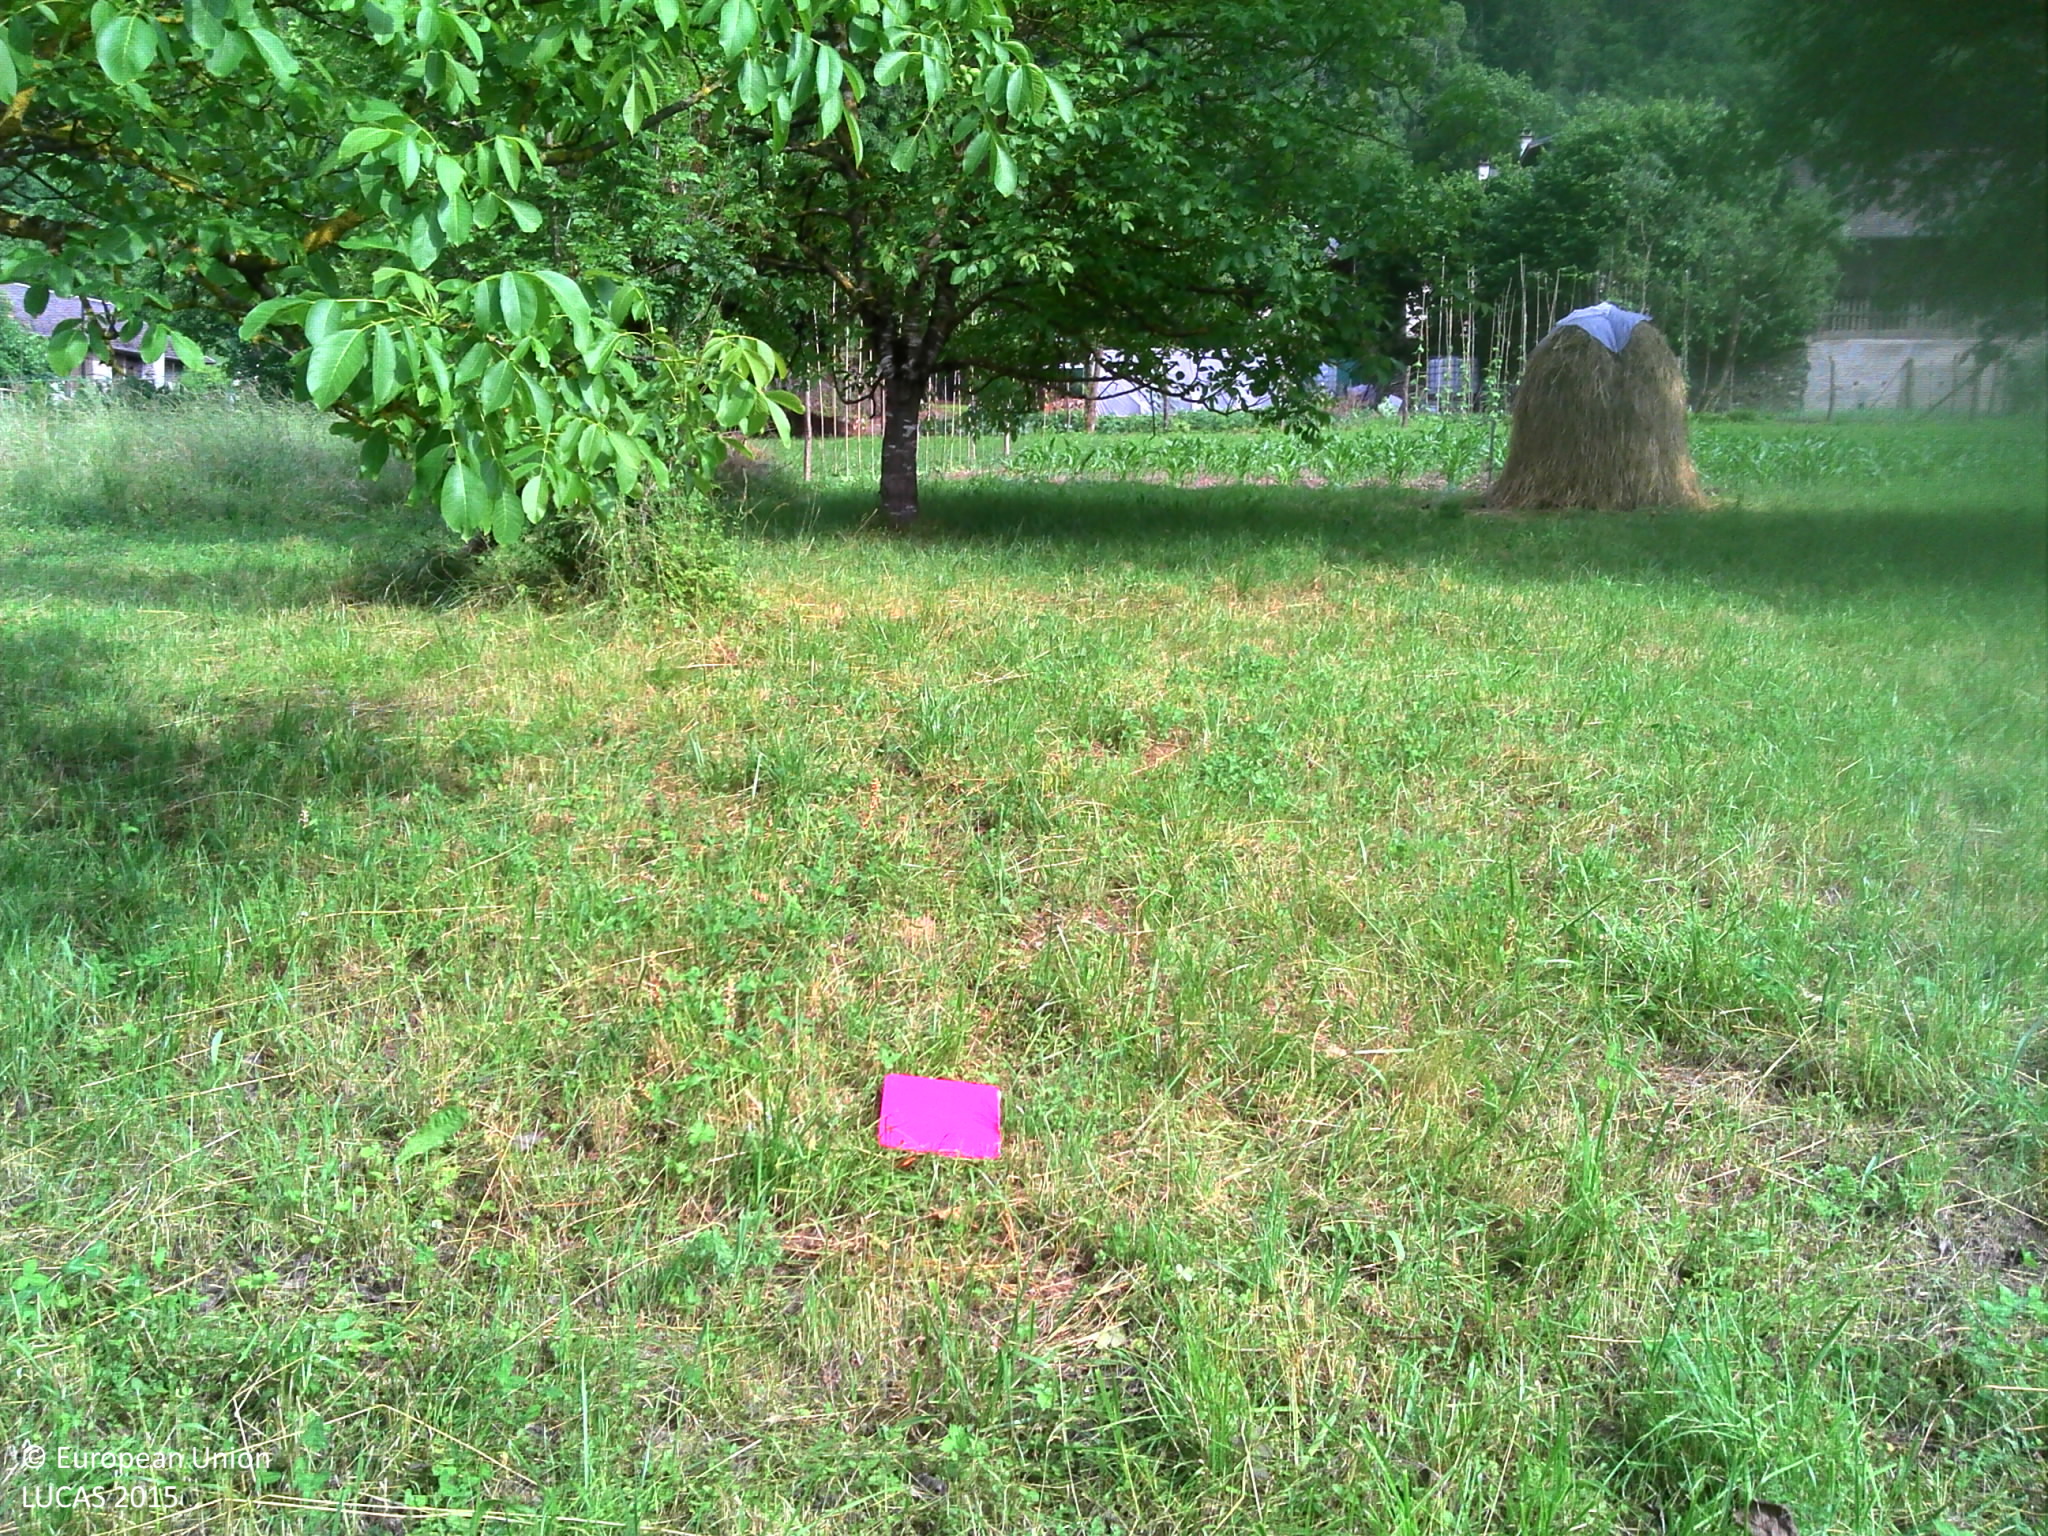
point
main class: Cropland
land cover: Nuts trees
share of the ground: < 10 %
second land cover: Grassland without tree/shrub cover
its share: > 75 %
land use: Agriculture (excluding fallow land and kitchen gardens)
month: June
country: FR
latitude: 45.5263
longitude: 6.2020
